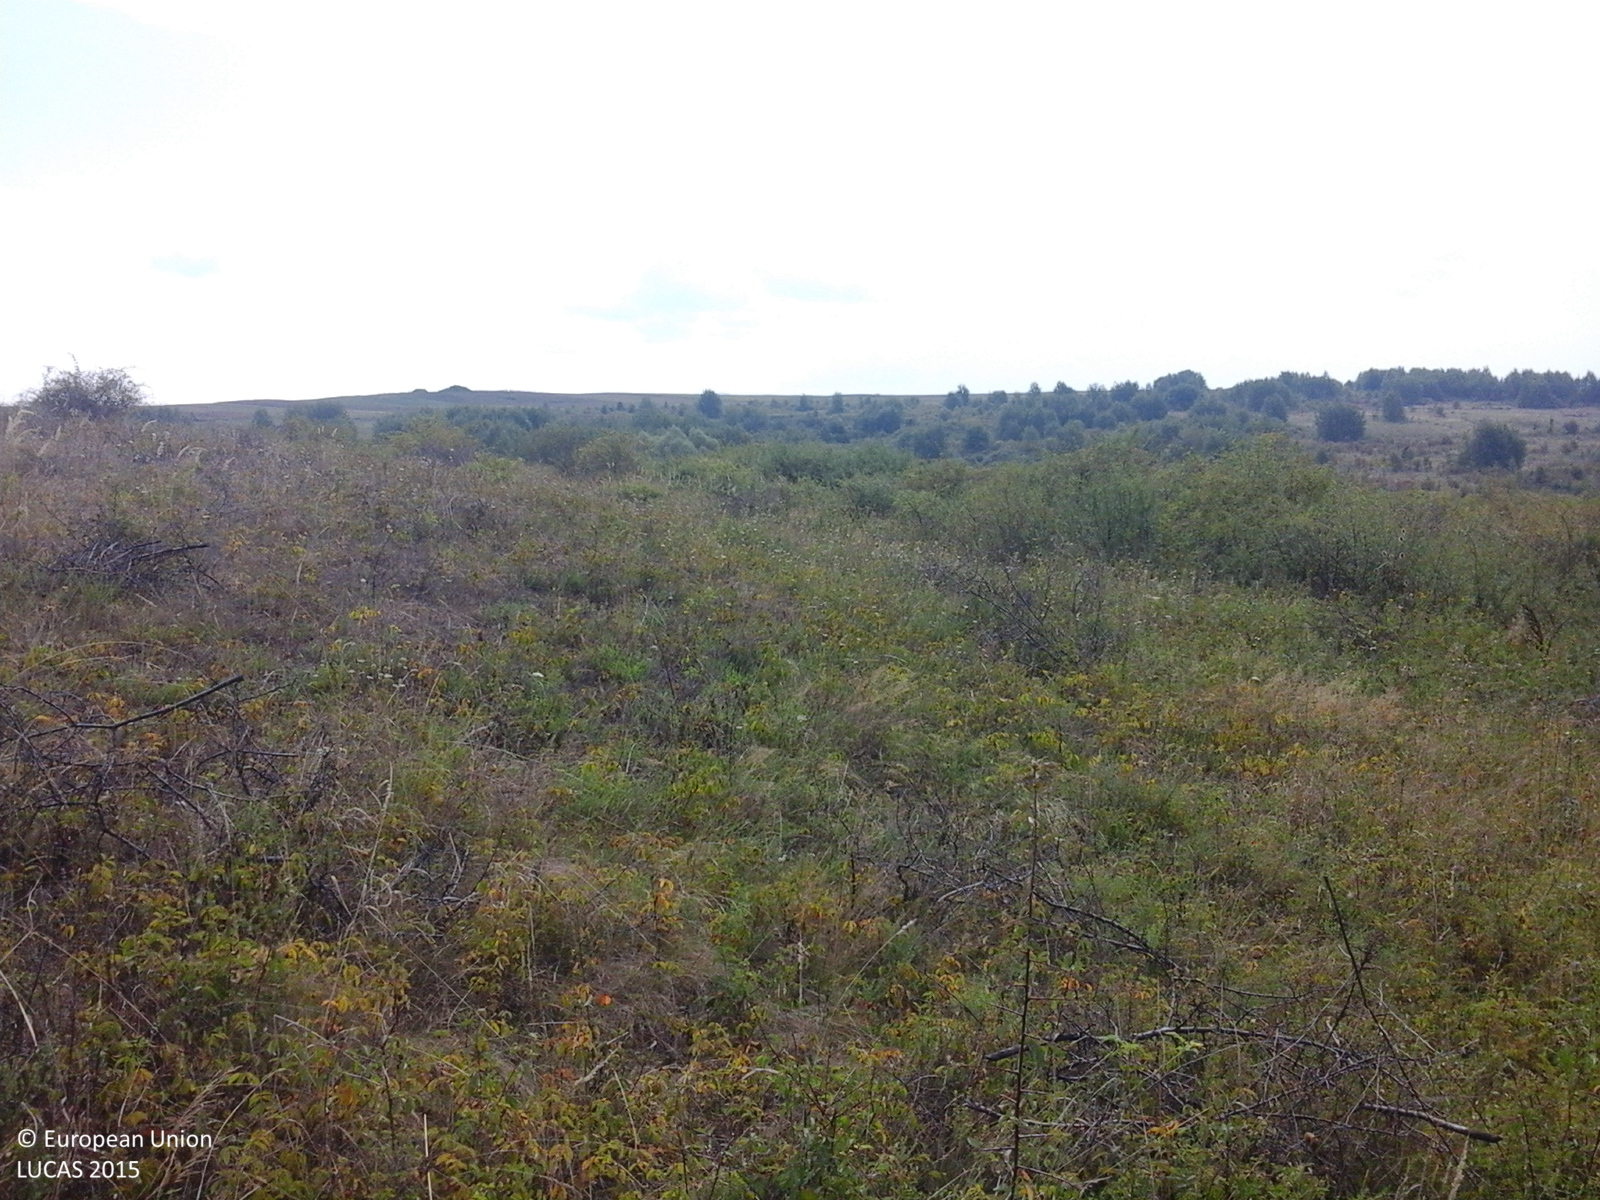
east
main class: Shrubland
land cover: Shrubland with sparse tree cover
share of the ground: > 75 %
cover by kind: shrubs 95 %, broadleaved forest trees 5 %
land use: Forestry
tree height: < 5 m
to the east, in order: Shrubland with sparse tree cover; Grassland with sparse tree/shrub cover; Tracks; Grassland with sparse tree/shrub cover
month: August
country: RO
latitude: 46.3394
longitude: 22.2201
